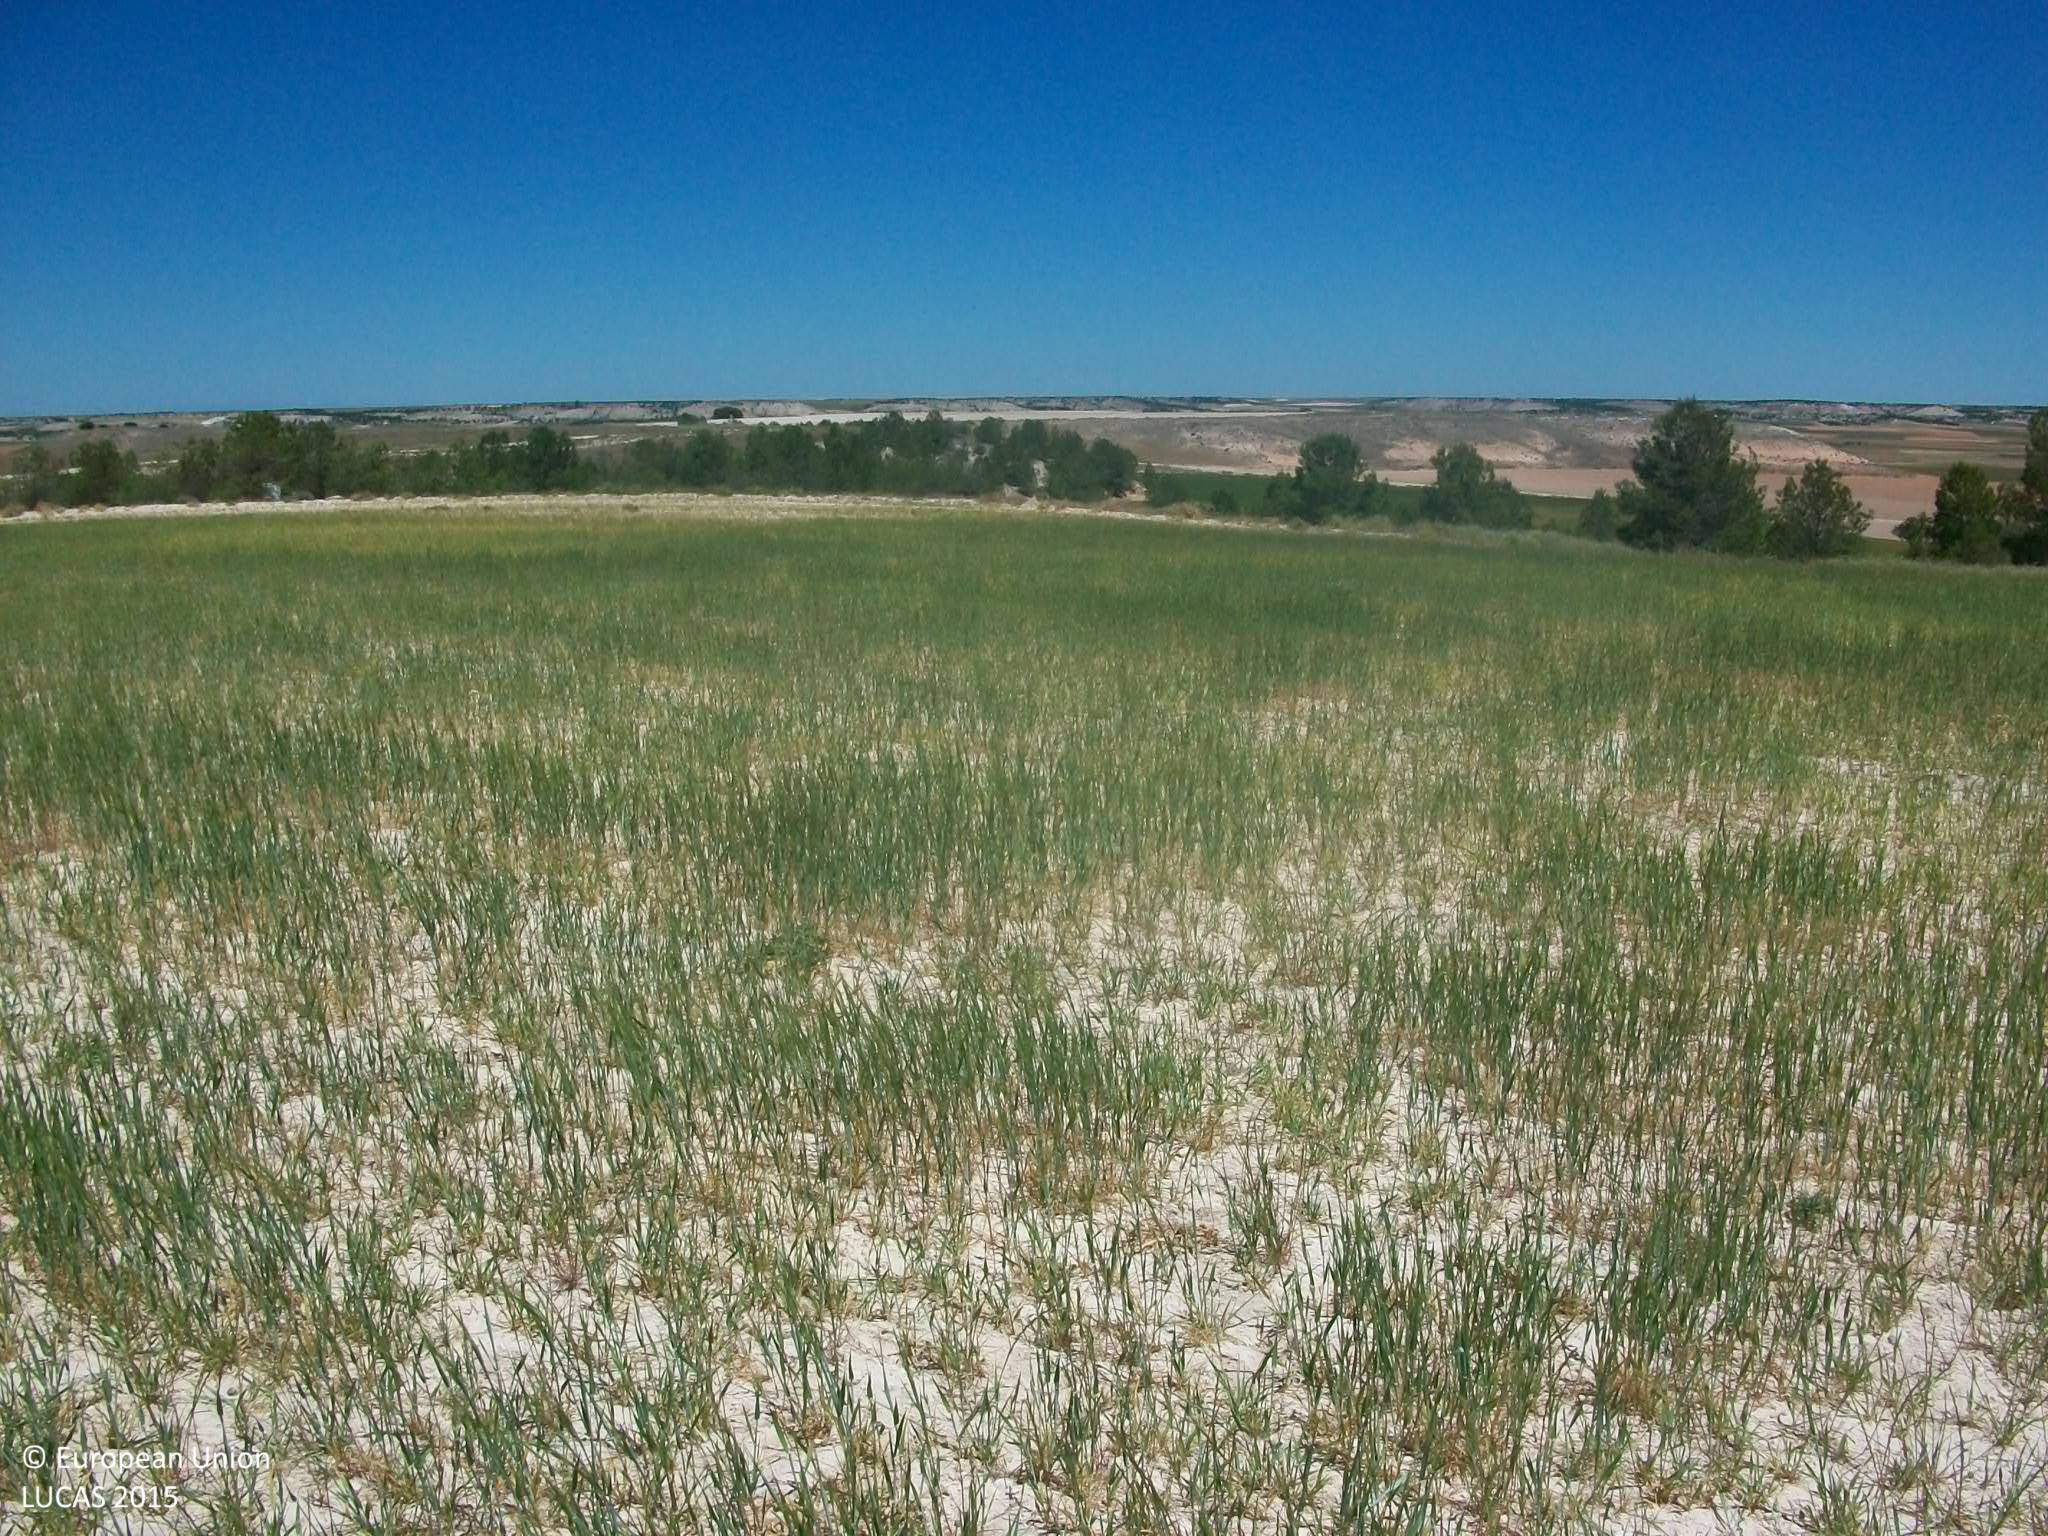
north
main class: Cropland
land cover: Common wheat
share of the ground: 50 - 75 %
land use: Agriculture (excluding fallow land and kitchen gardens)
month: May
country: ES
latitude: 39.6870
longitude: -3.5635
